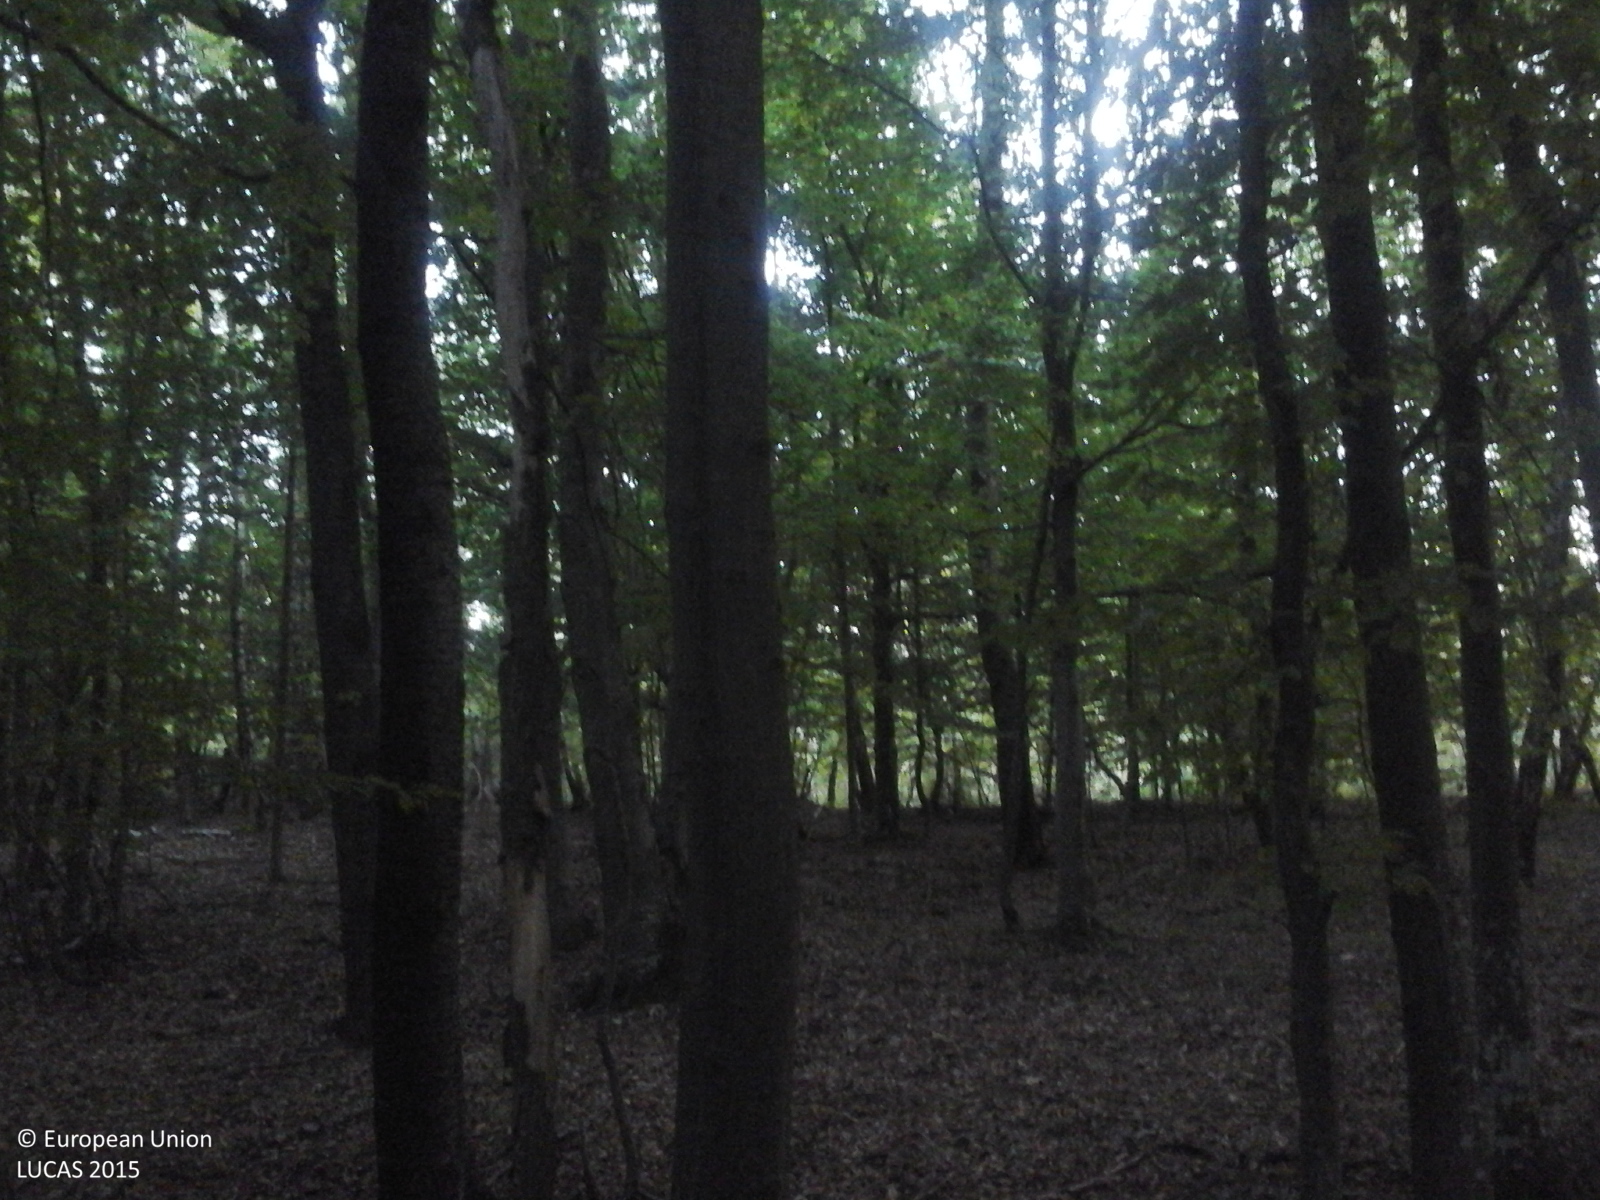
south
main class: Woodland
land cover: Broadleaved woodland
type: beech forest
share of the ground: > 75 %
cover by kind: broadleaved forest trees 100 %
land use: Forestry
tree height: > 5 m
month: September
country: RO
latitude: 47.1159
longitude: 22.5901
